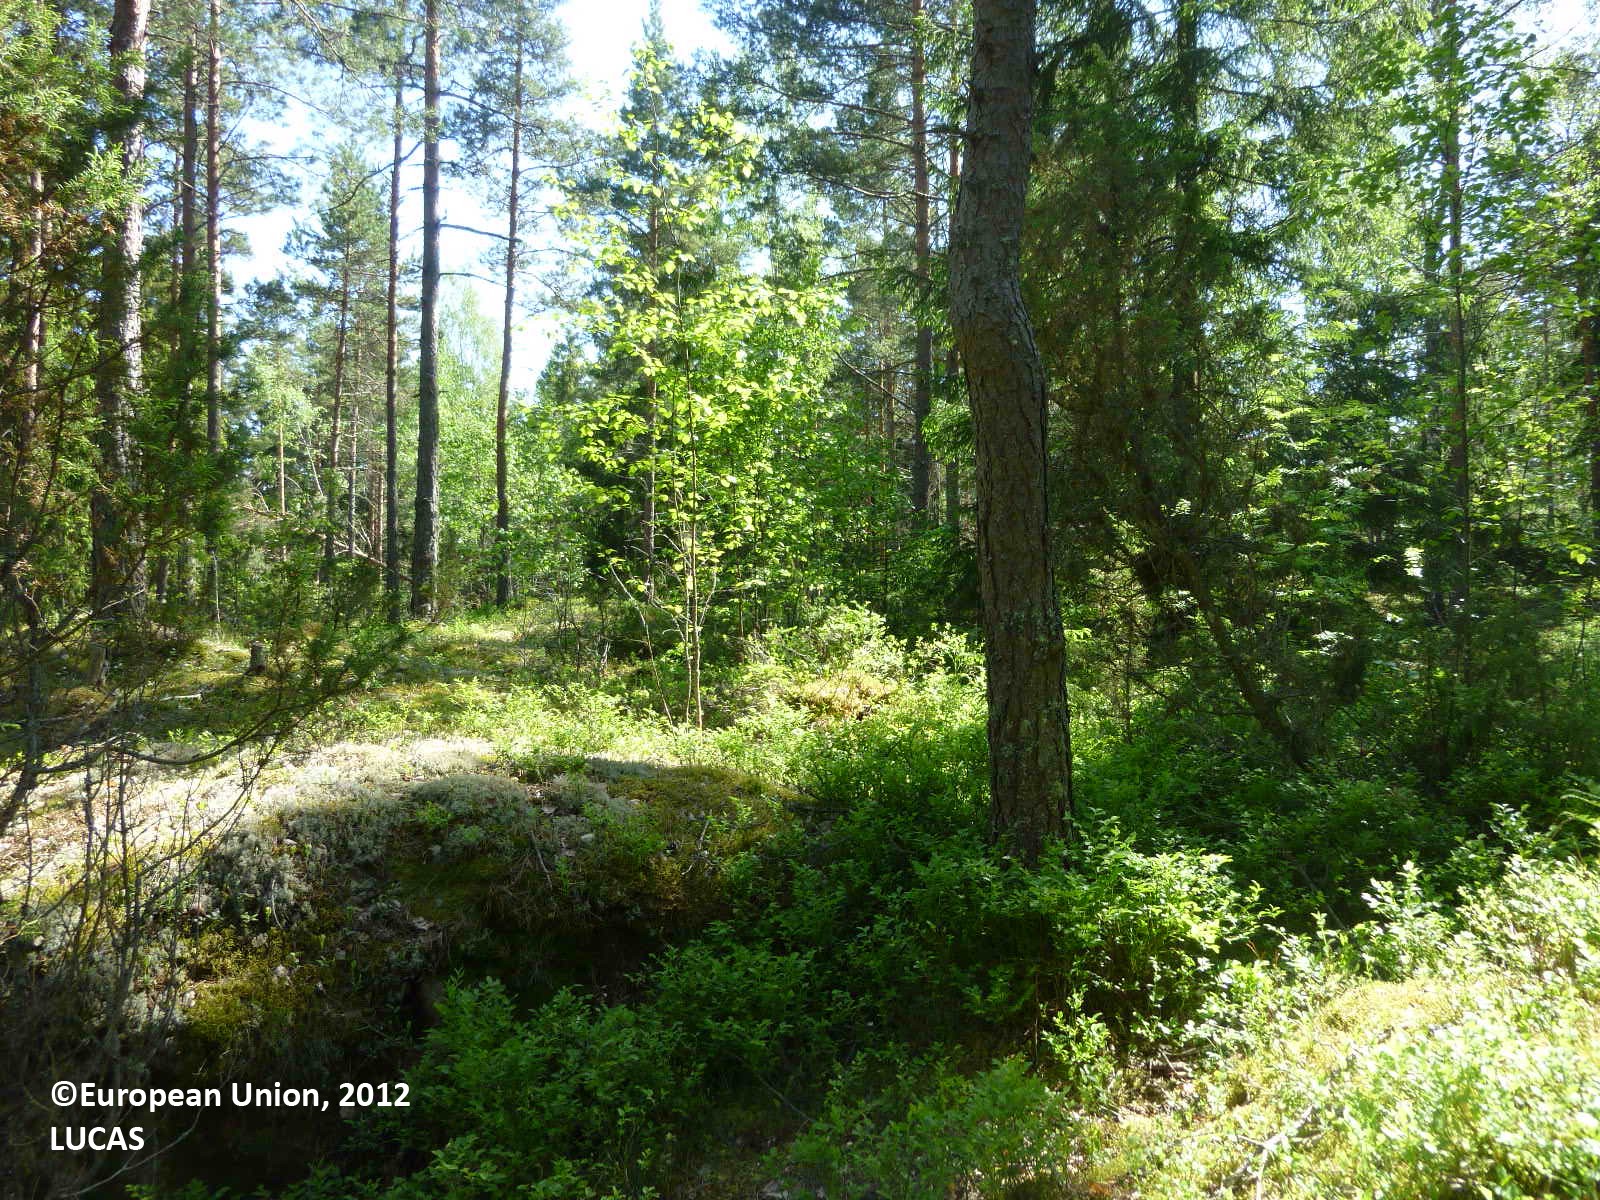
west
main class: Woodland
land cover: Pine dominated coniferous woodland
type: boreal forest
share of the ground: 50 - 75 %
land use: Forestry
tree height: > 5 m
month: June
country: FI
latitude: 60.4148
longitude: 22.6197
